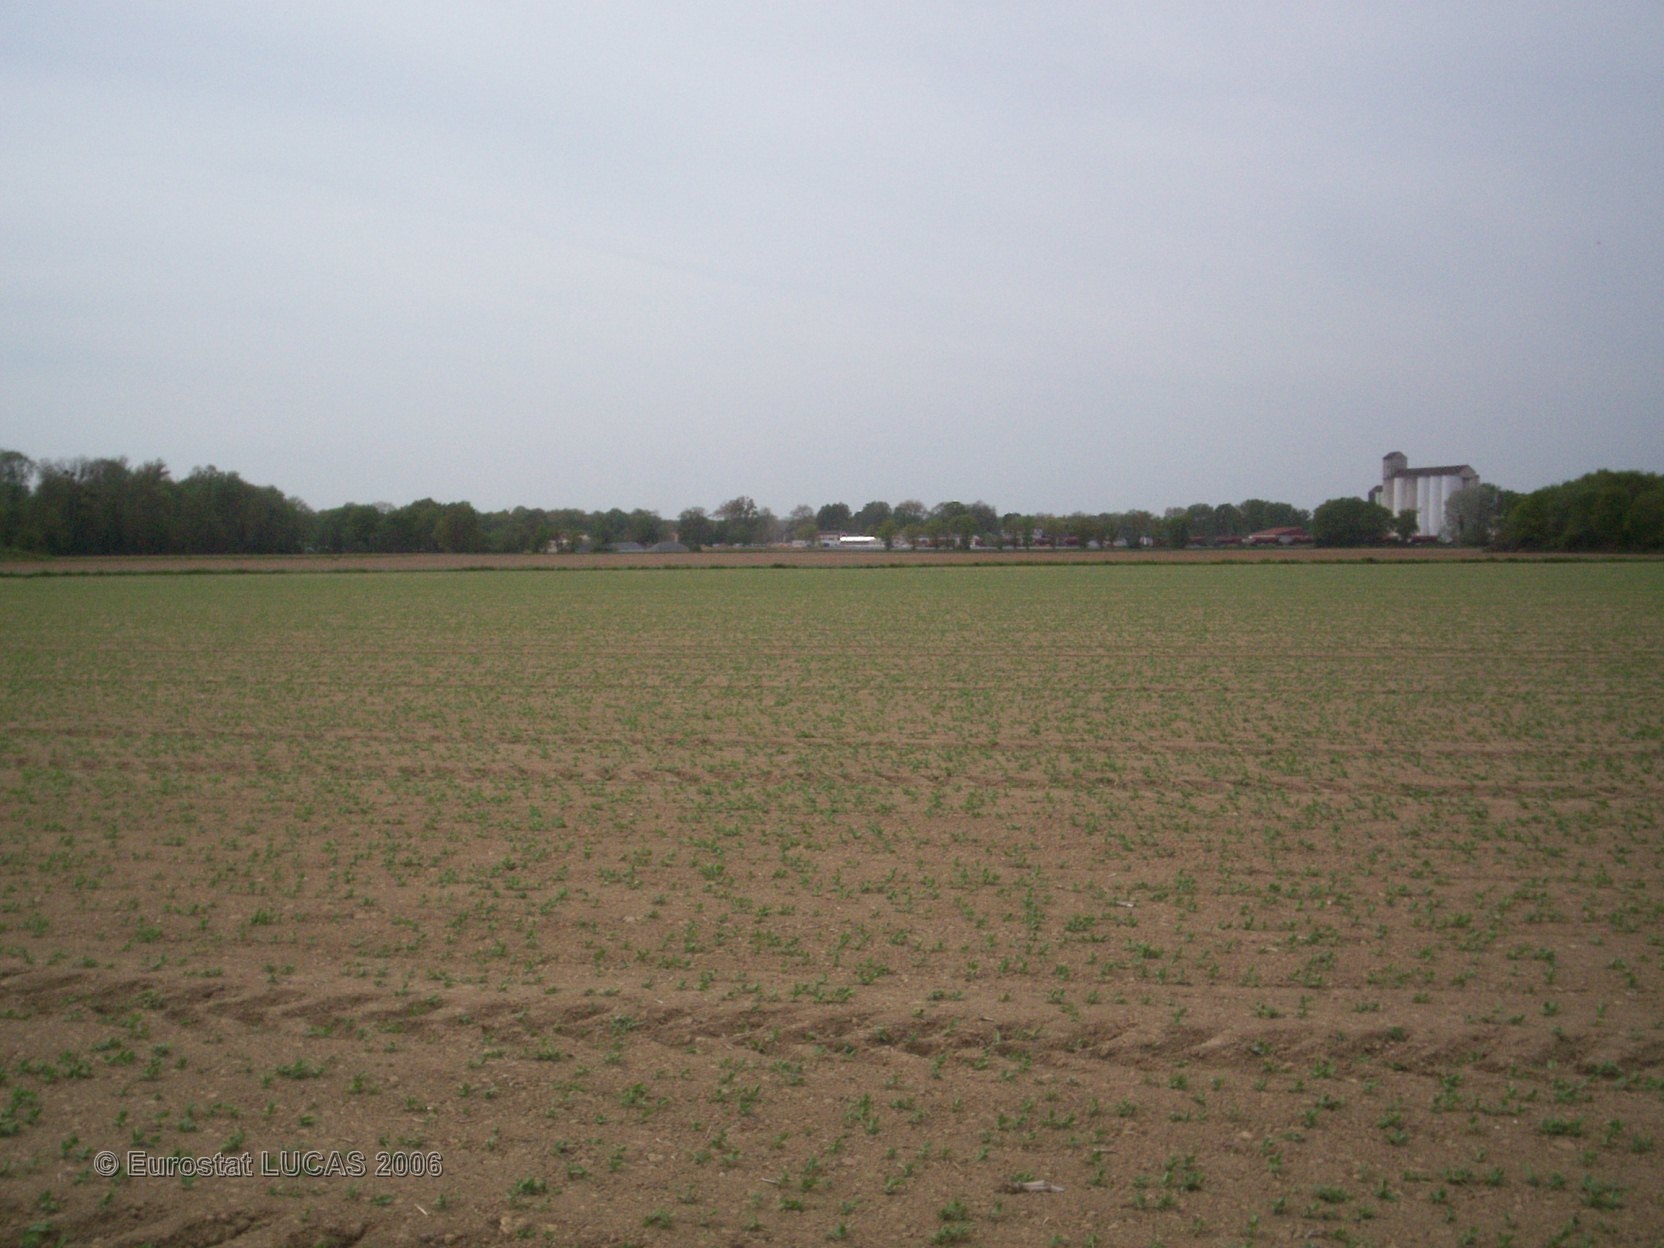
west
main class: Cropland
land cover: Dry pulses
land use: Agriculture (excluding fallow land and kitchen gardens)
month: May
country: FR
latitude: 48.7337
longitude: 2.8800
